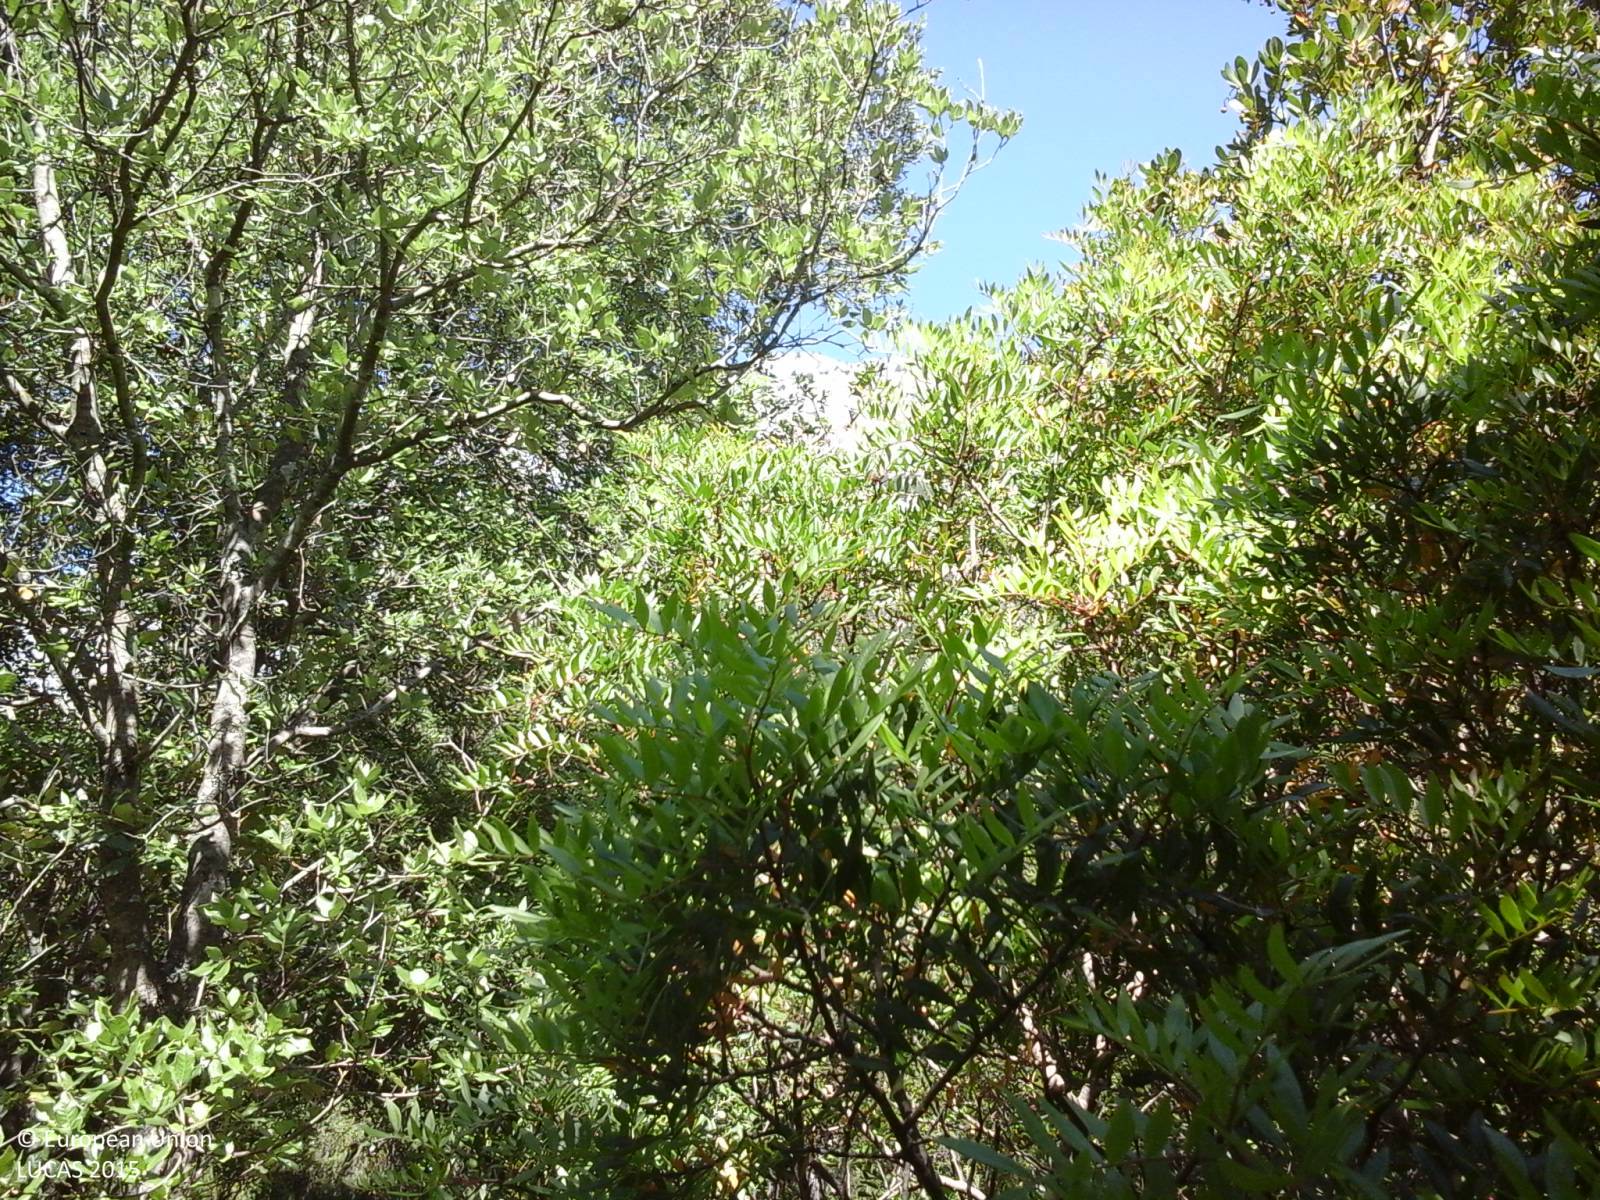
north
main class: Woodland
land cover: Broadleaved woodland
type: broadleaved evergreen forest
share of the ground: > 75 %
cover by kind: broadleaved forest trees 95 %, shrubs 5 %
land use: Semi-natural and natural areas not in use
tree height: < 5 m
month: May
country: IT
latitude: 40.2660
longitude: 9.4970
